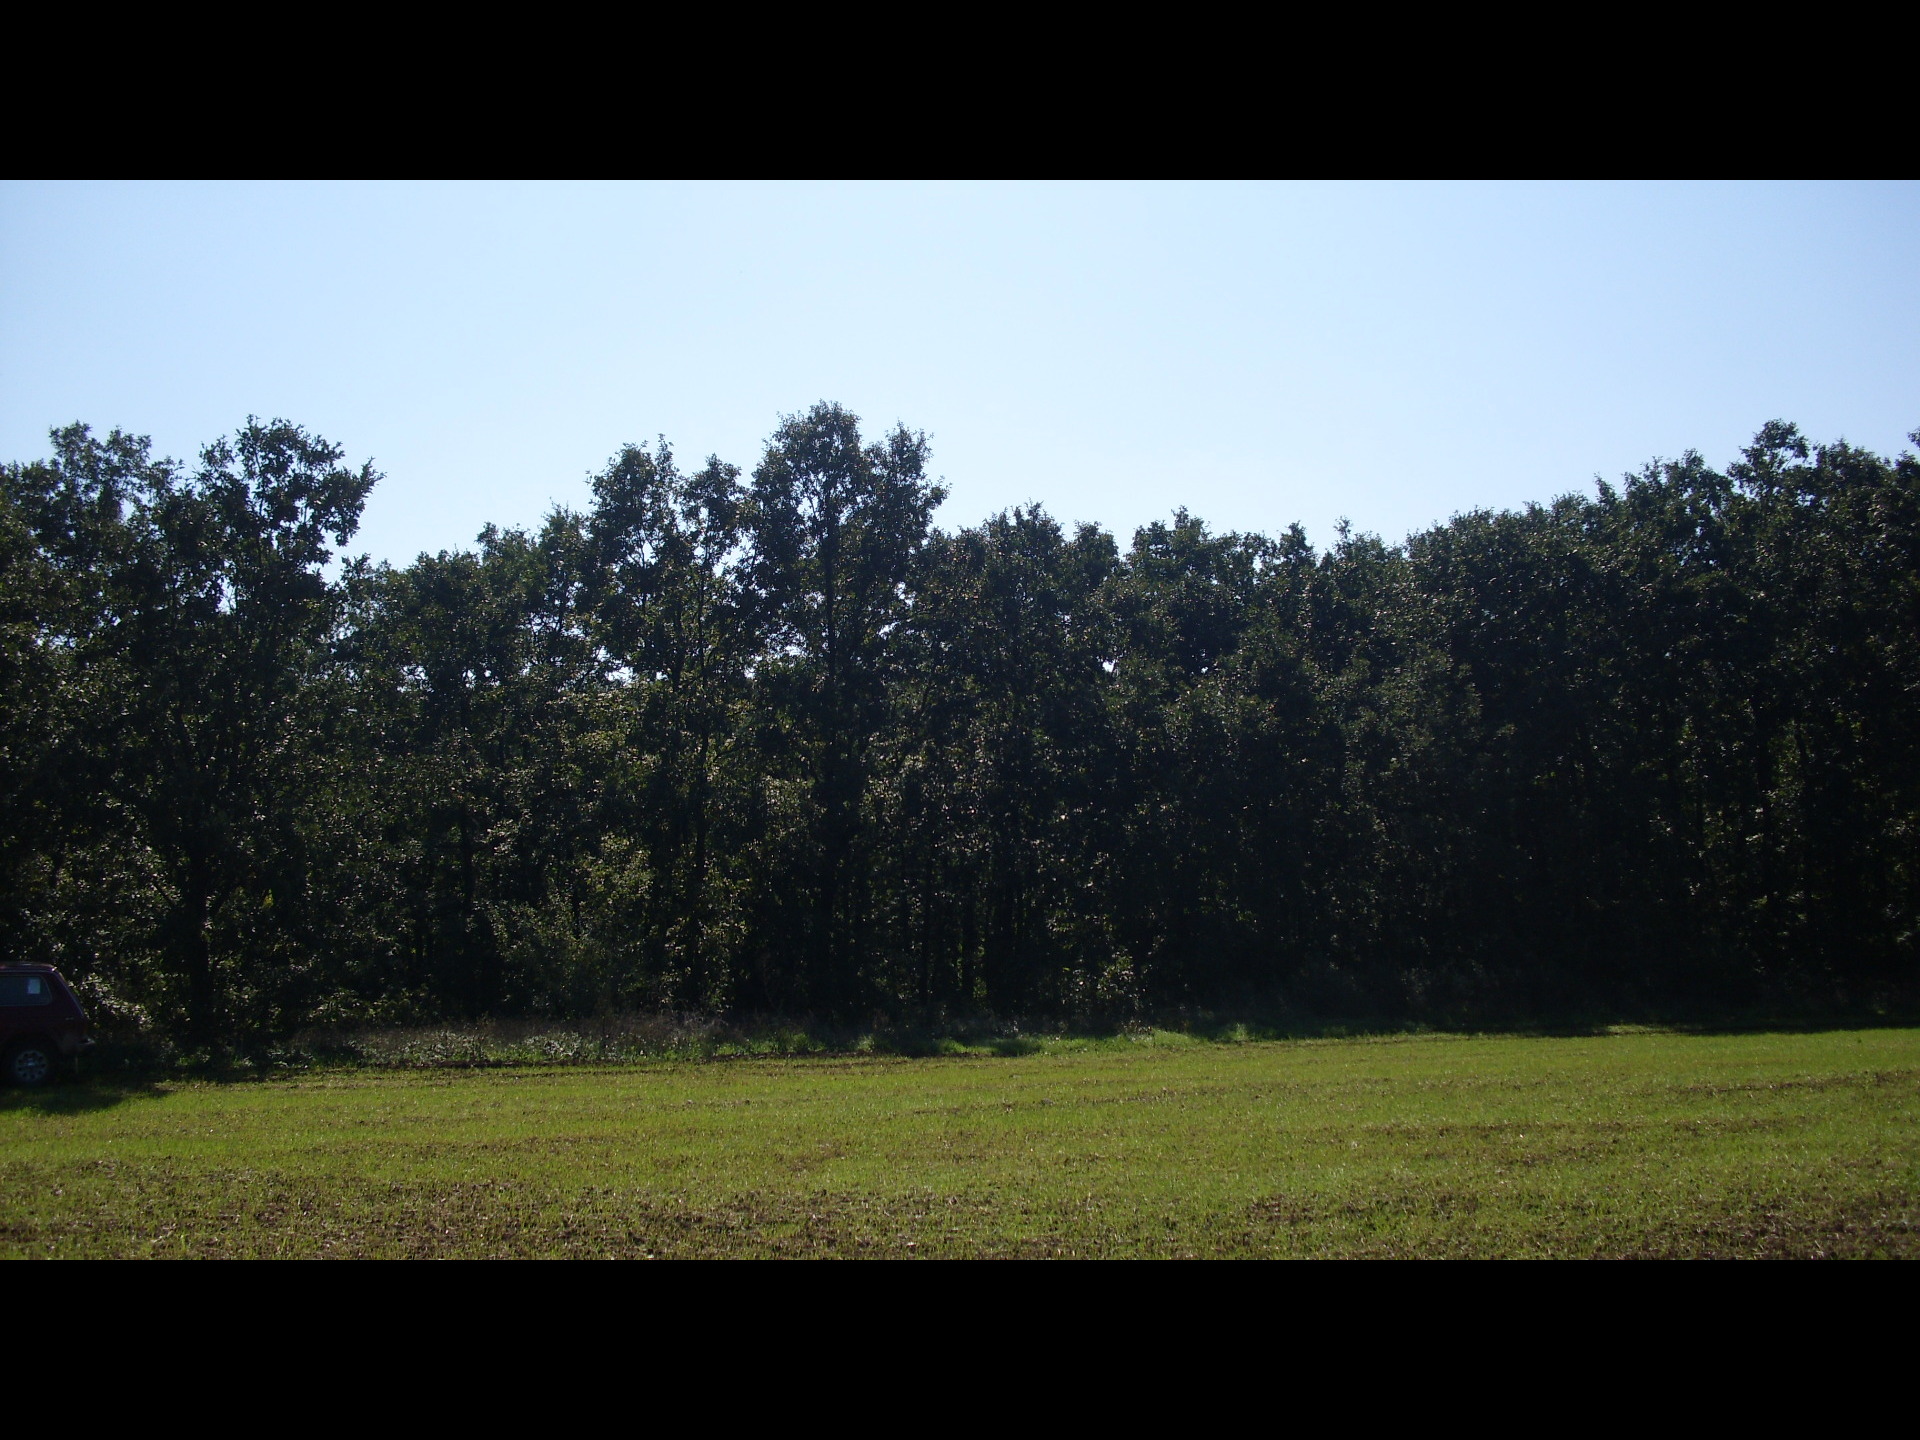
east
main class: Cropland
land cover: Common wheat
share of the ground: < 10 %
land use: Agriculture (excluding fallow land and kitchen gardens)
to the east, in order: Common wheat; Grassland without tree/shrub cover; Broadleaved woodland
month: October
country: BG
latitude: 43.8538
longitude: 22.7381
